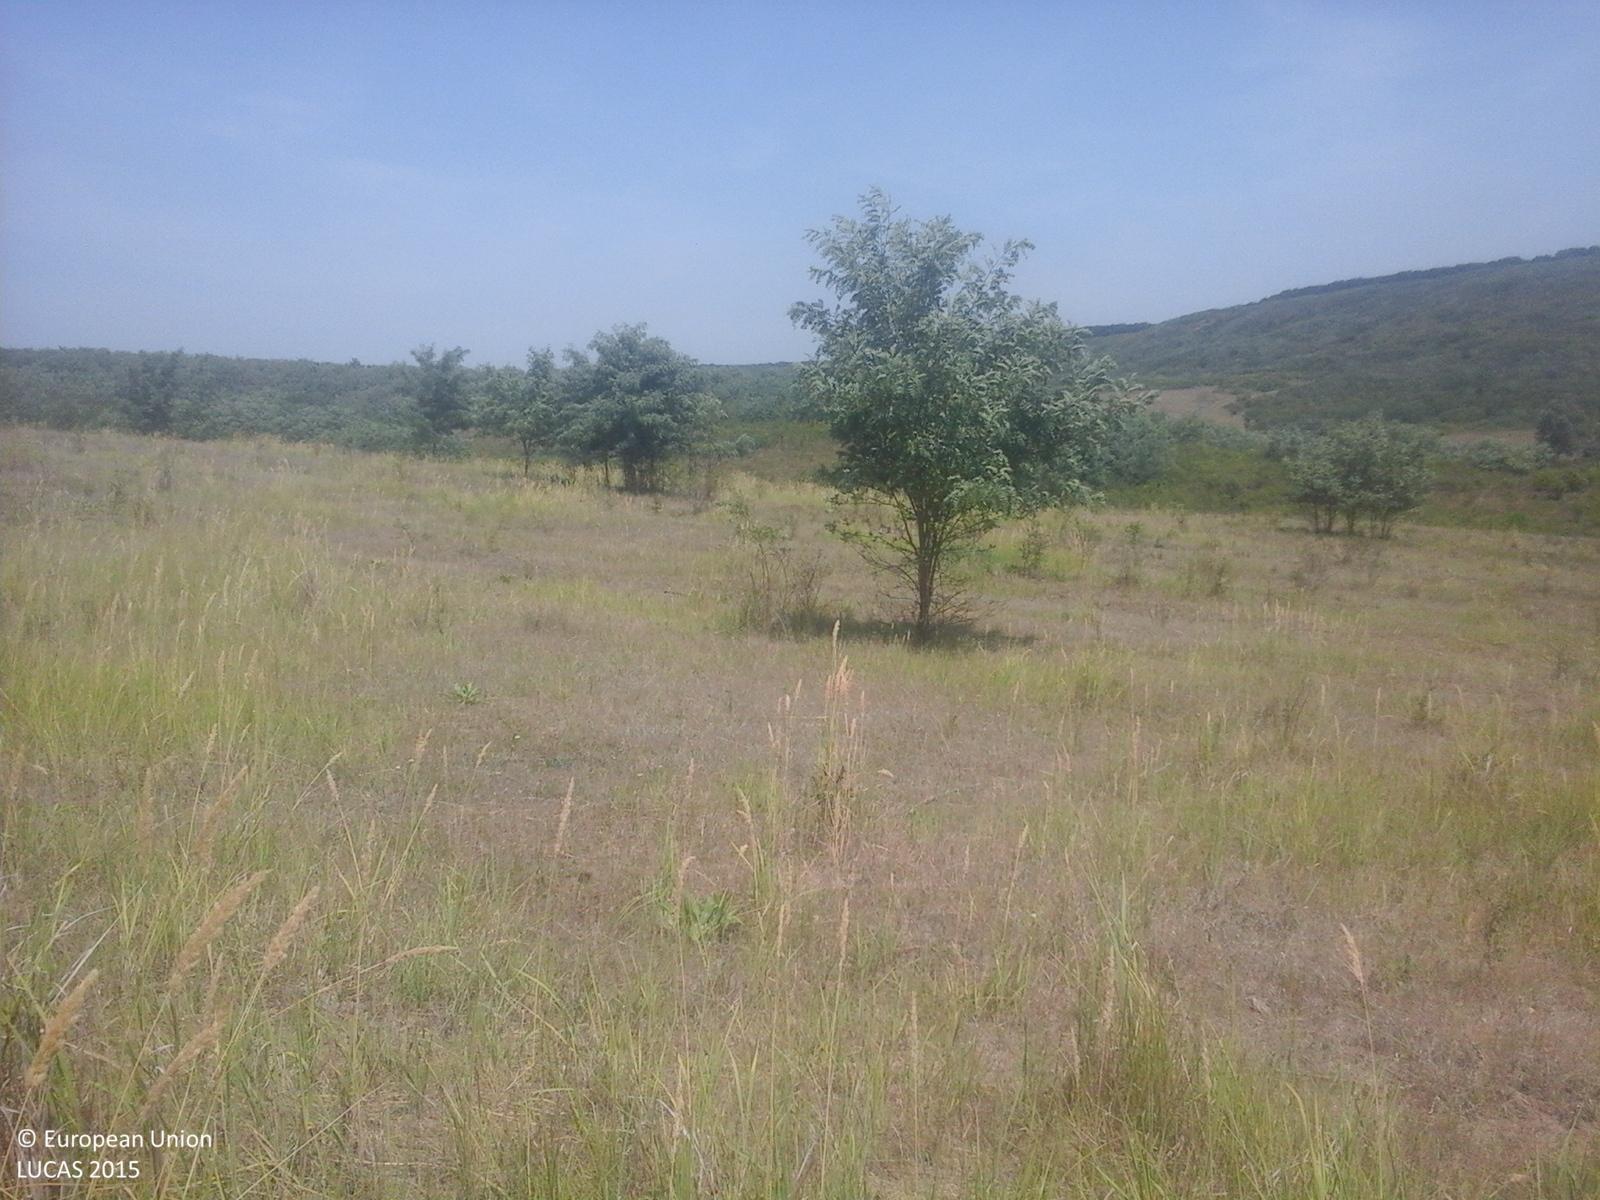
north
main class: Grassland
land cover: Grassland without tree/shrub cover
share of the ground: > 75 %
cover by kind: herbaceous plants 100 %
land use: Agriculture (excluding fallow land and kitchen gardens)
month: July
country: RO
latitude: 46.7054
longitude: 28.0081
